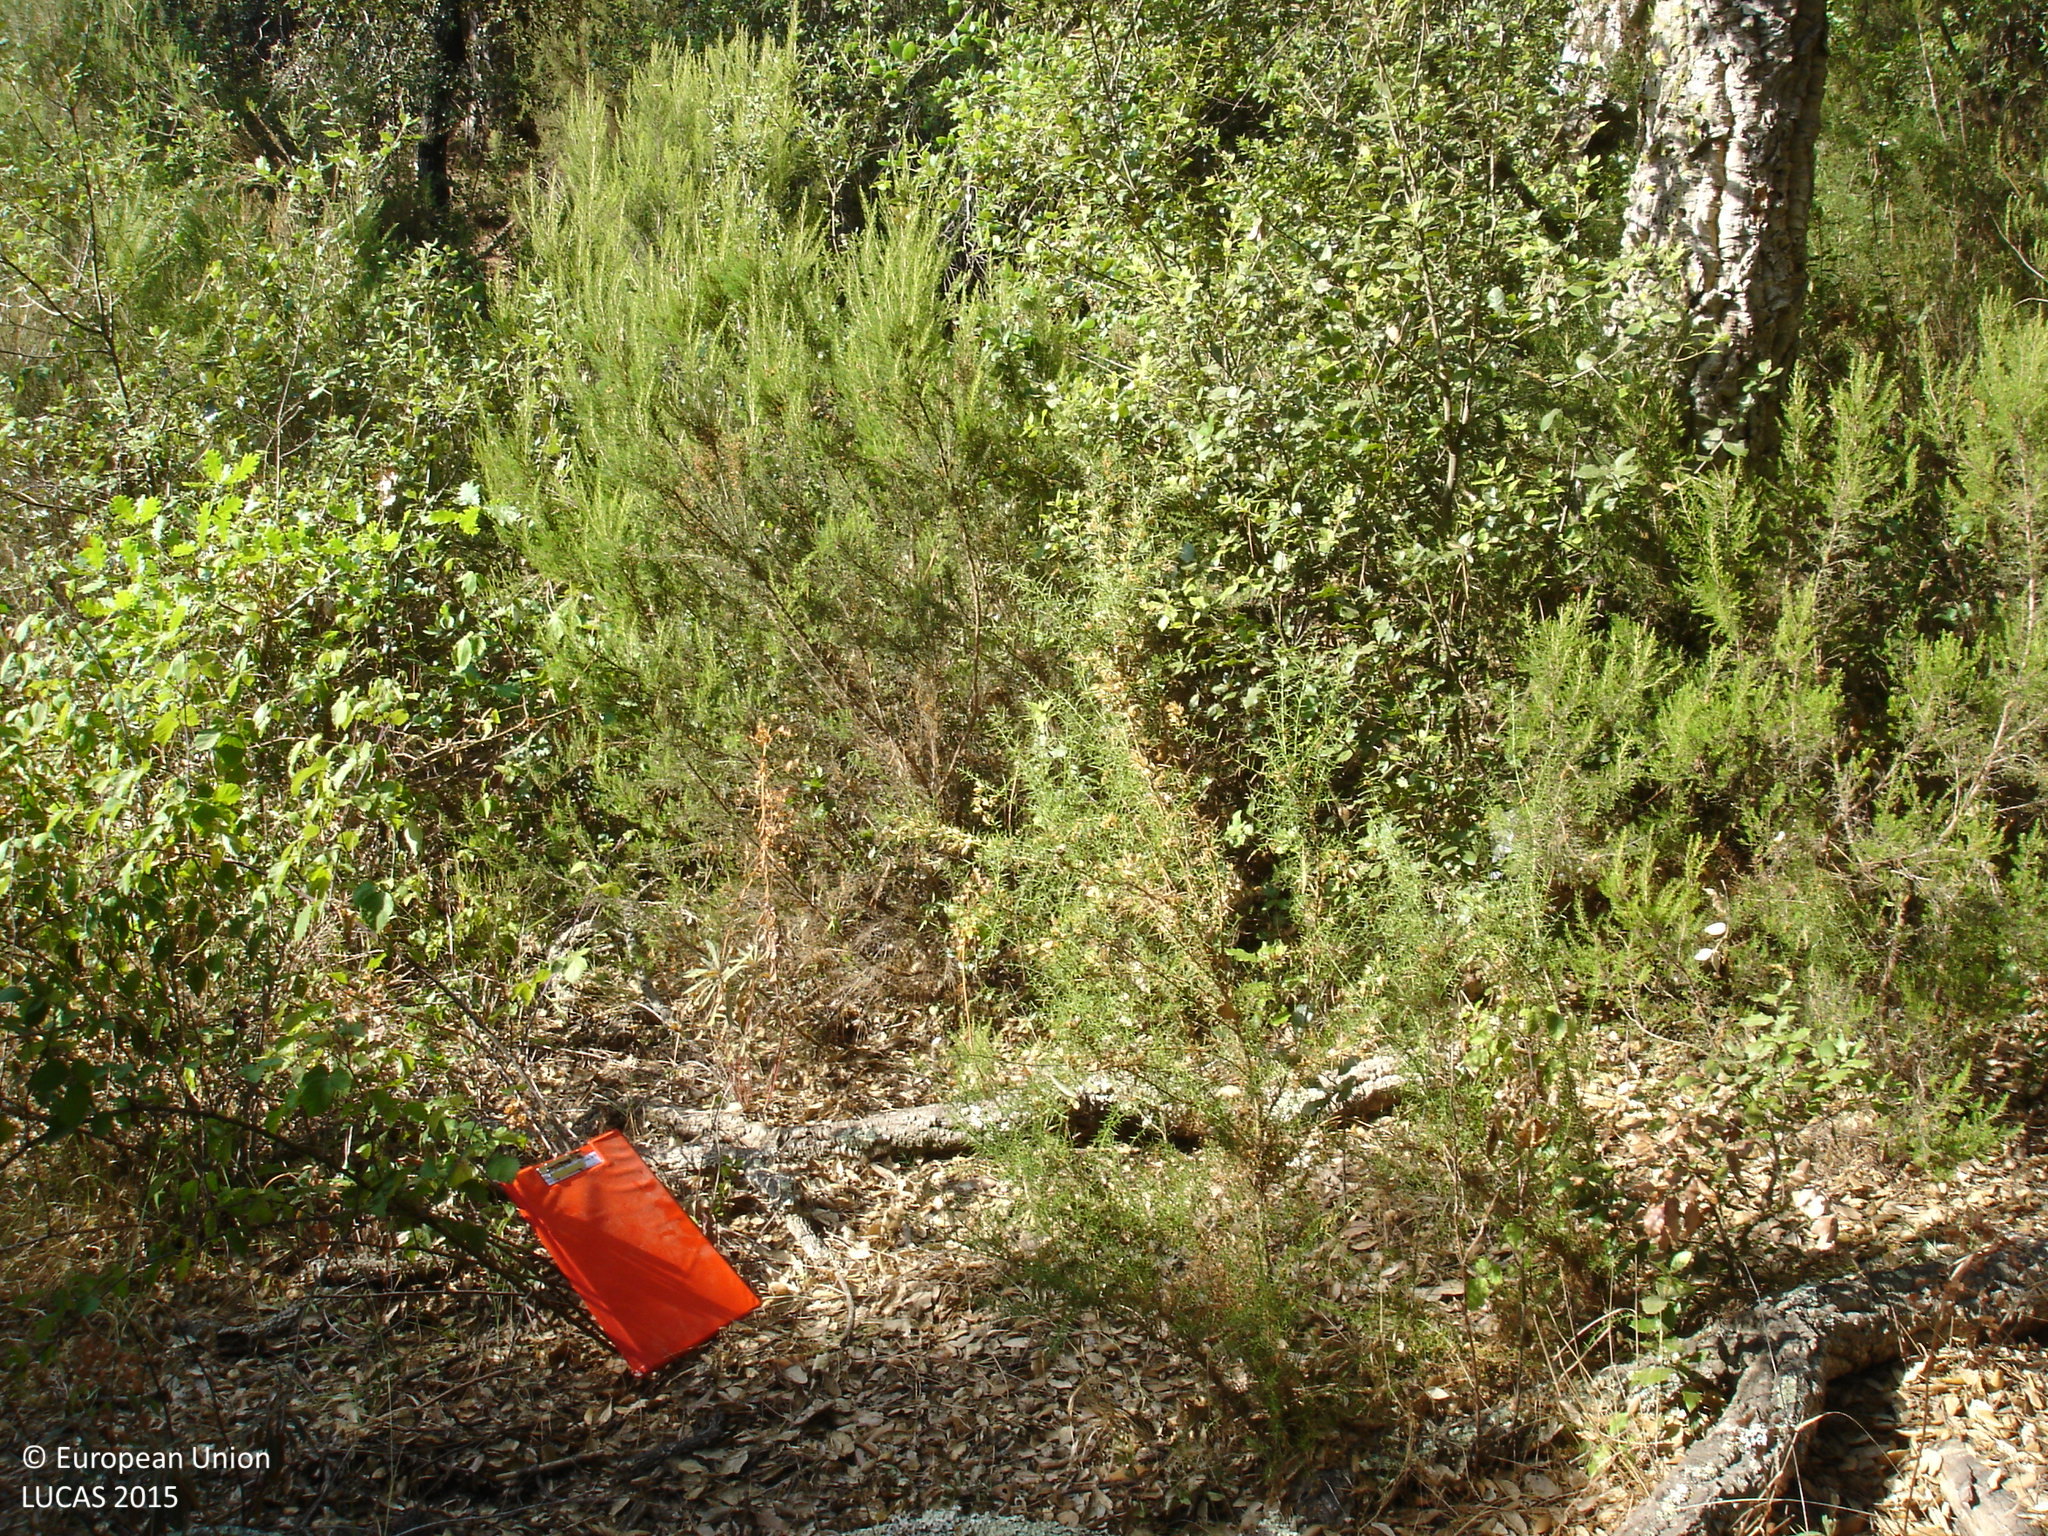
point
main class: Woodland
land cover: Other mixed woodland
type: thermophilous deciduous forest
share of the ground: > 75 %
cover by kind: broadleaved forest trees 60 %, coniferous forest trees 20 %, shrubs 15 %, herbaceous plants 5 %
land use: Forestry
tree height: > 5 m
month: July
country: ES
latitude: 41.9476
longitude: 3.1040
